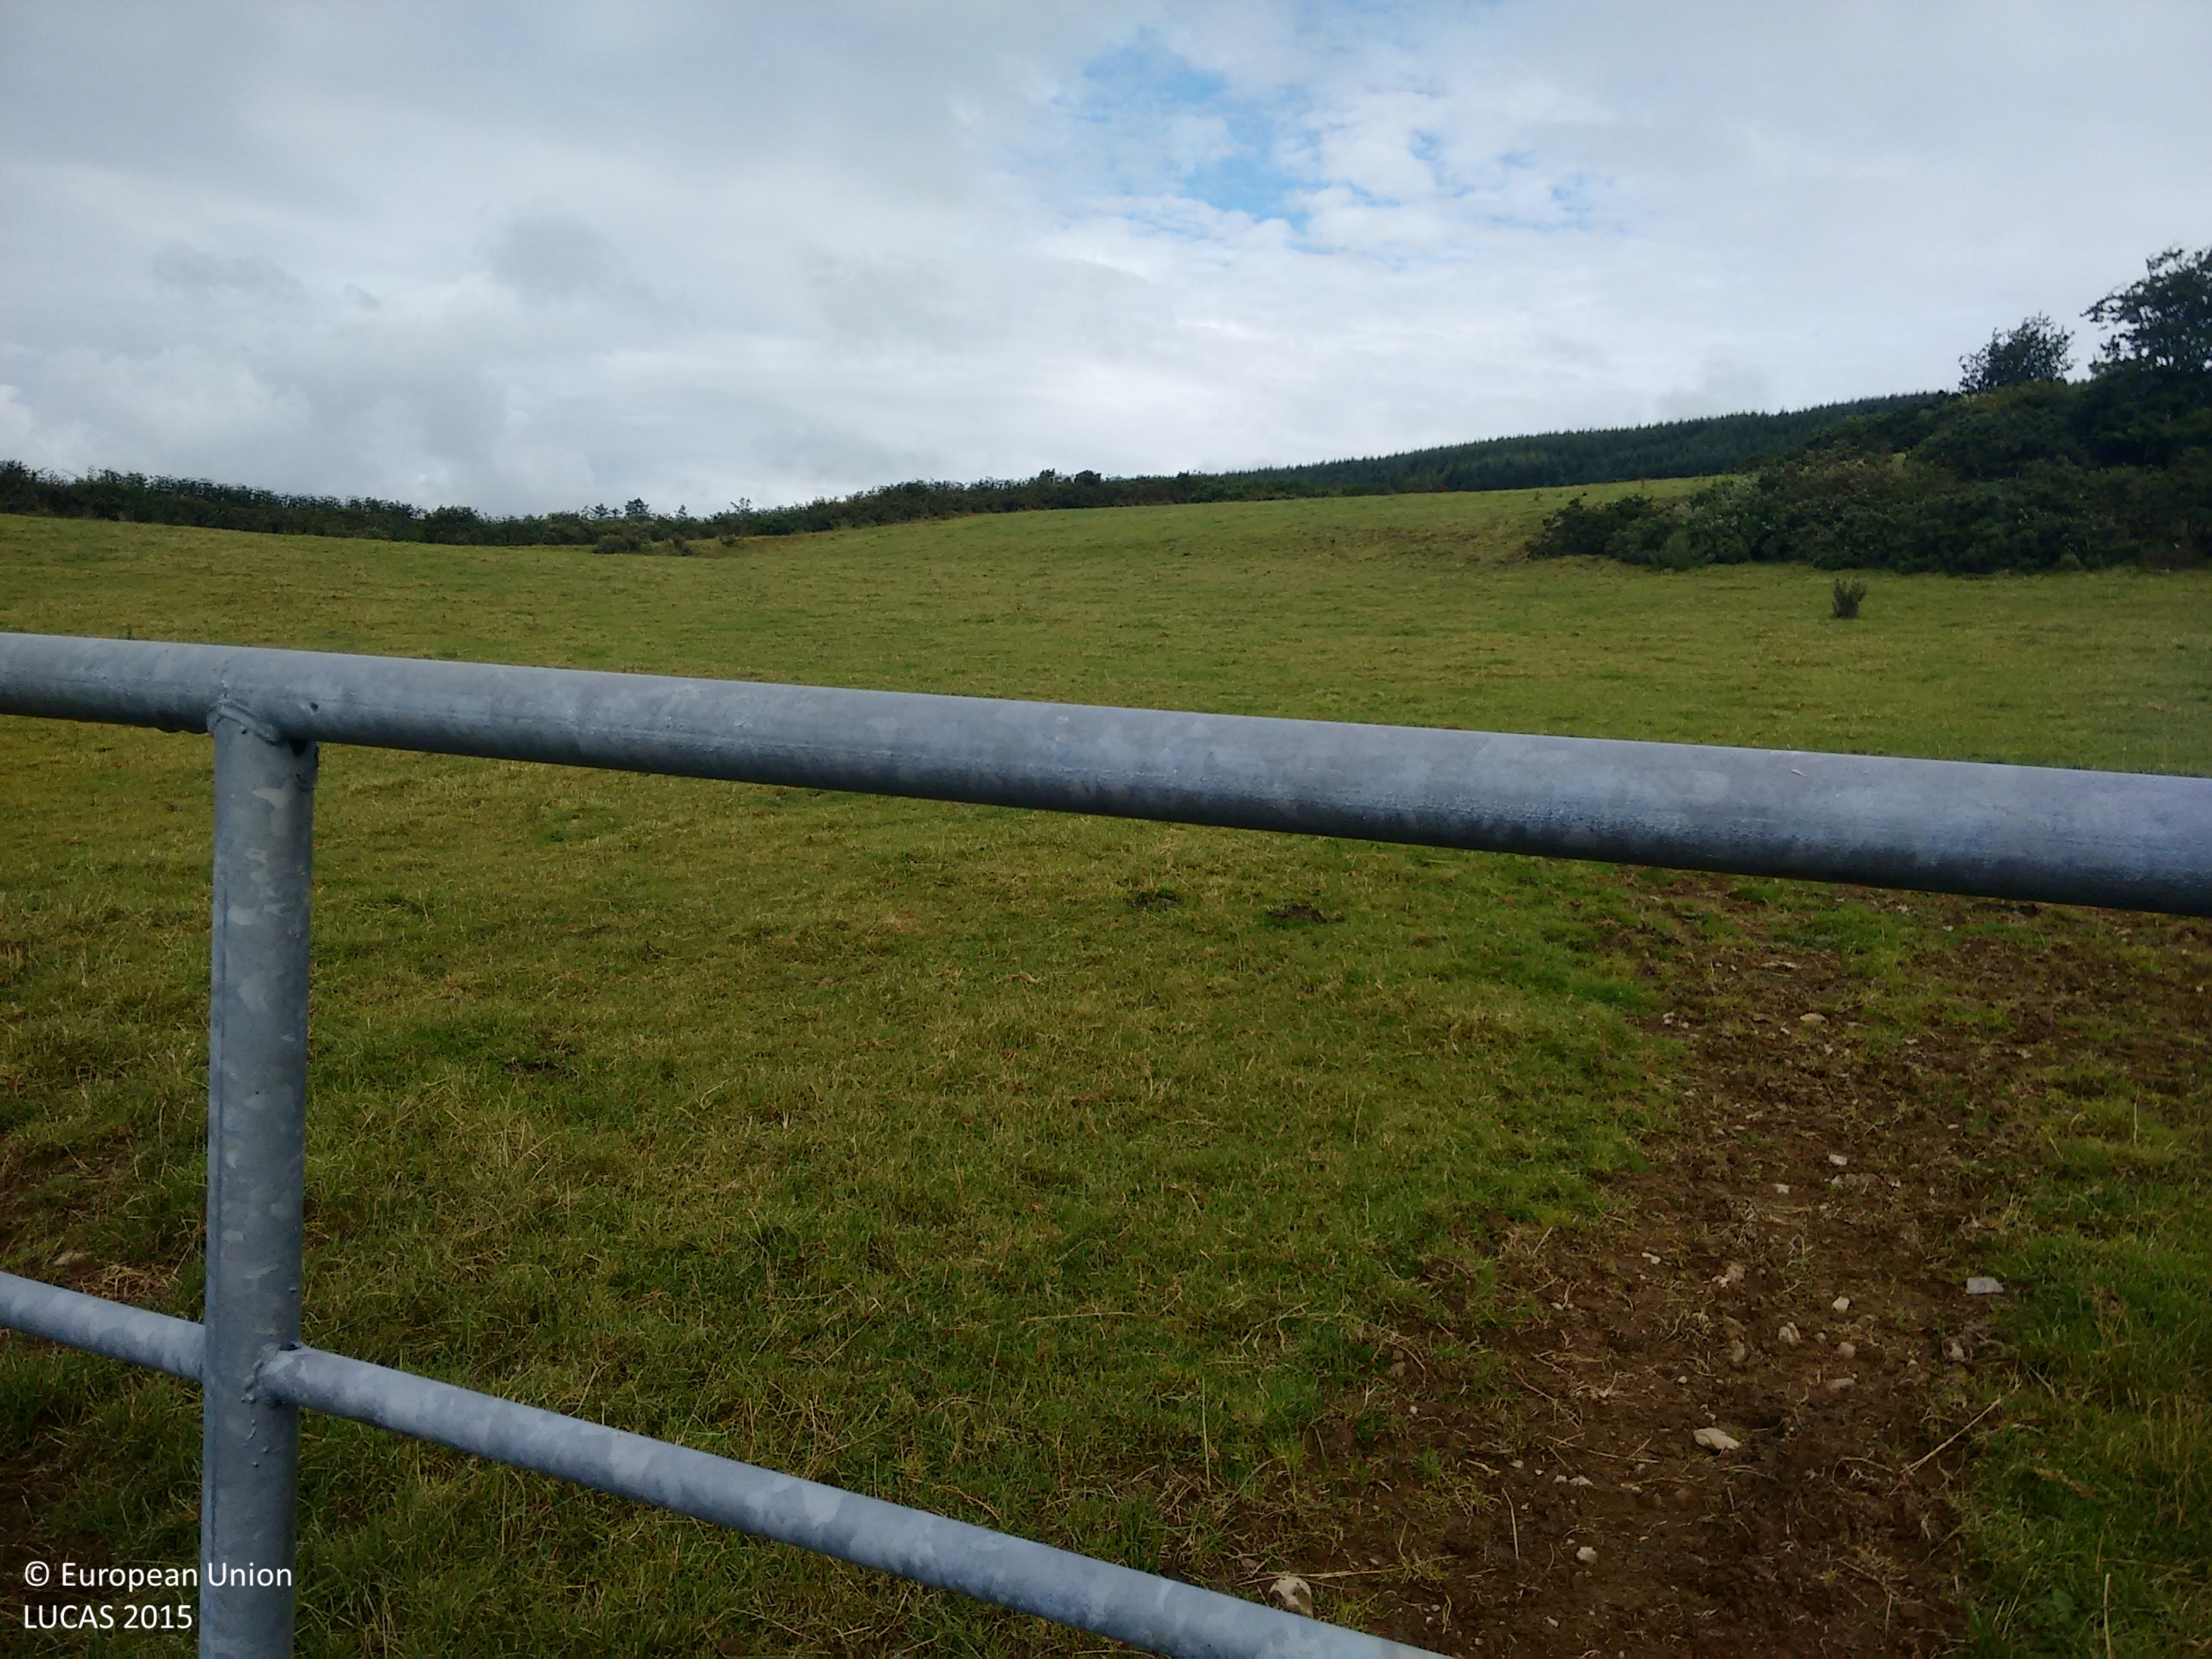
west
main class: Grassland
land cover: Grassland without tree/shrub cover
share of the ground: > 75 %
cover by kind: herbaceous plants 95 %, shrubs 5 %
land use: Agriculture (excluding fallow land and kitchen gardens)
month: July
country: IE
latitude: 51.6624
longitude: -9.1728
